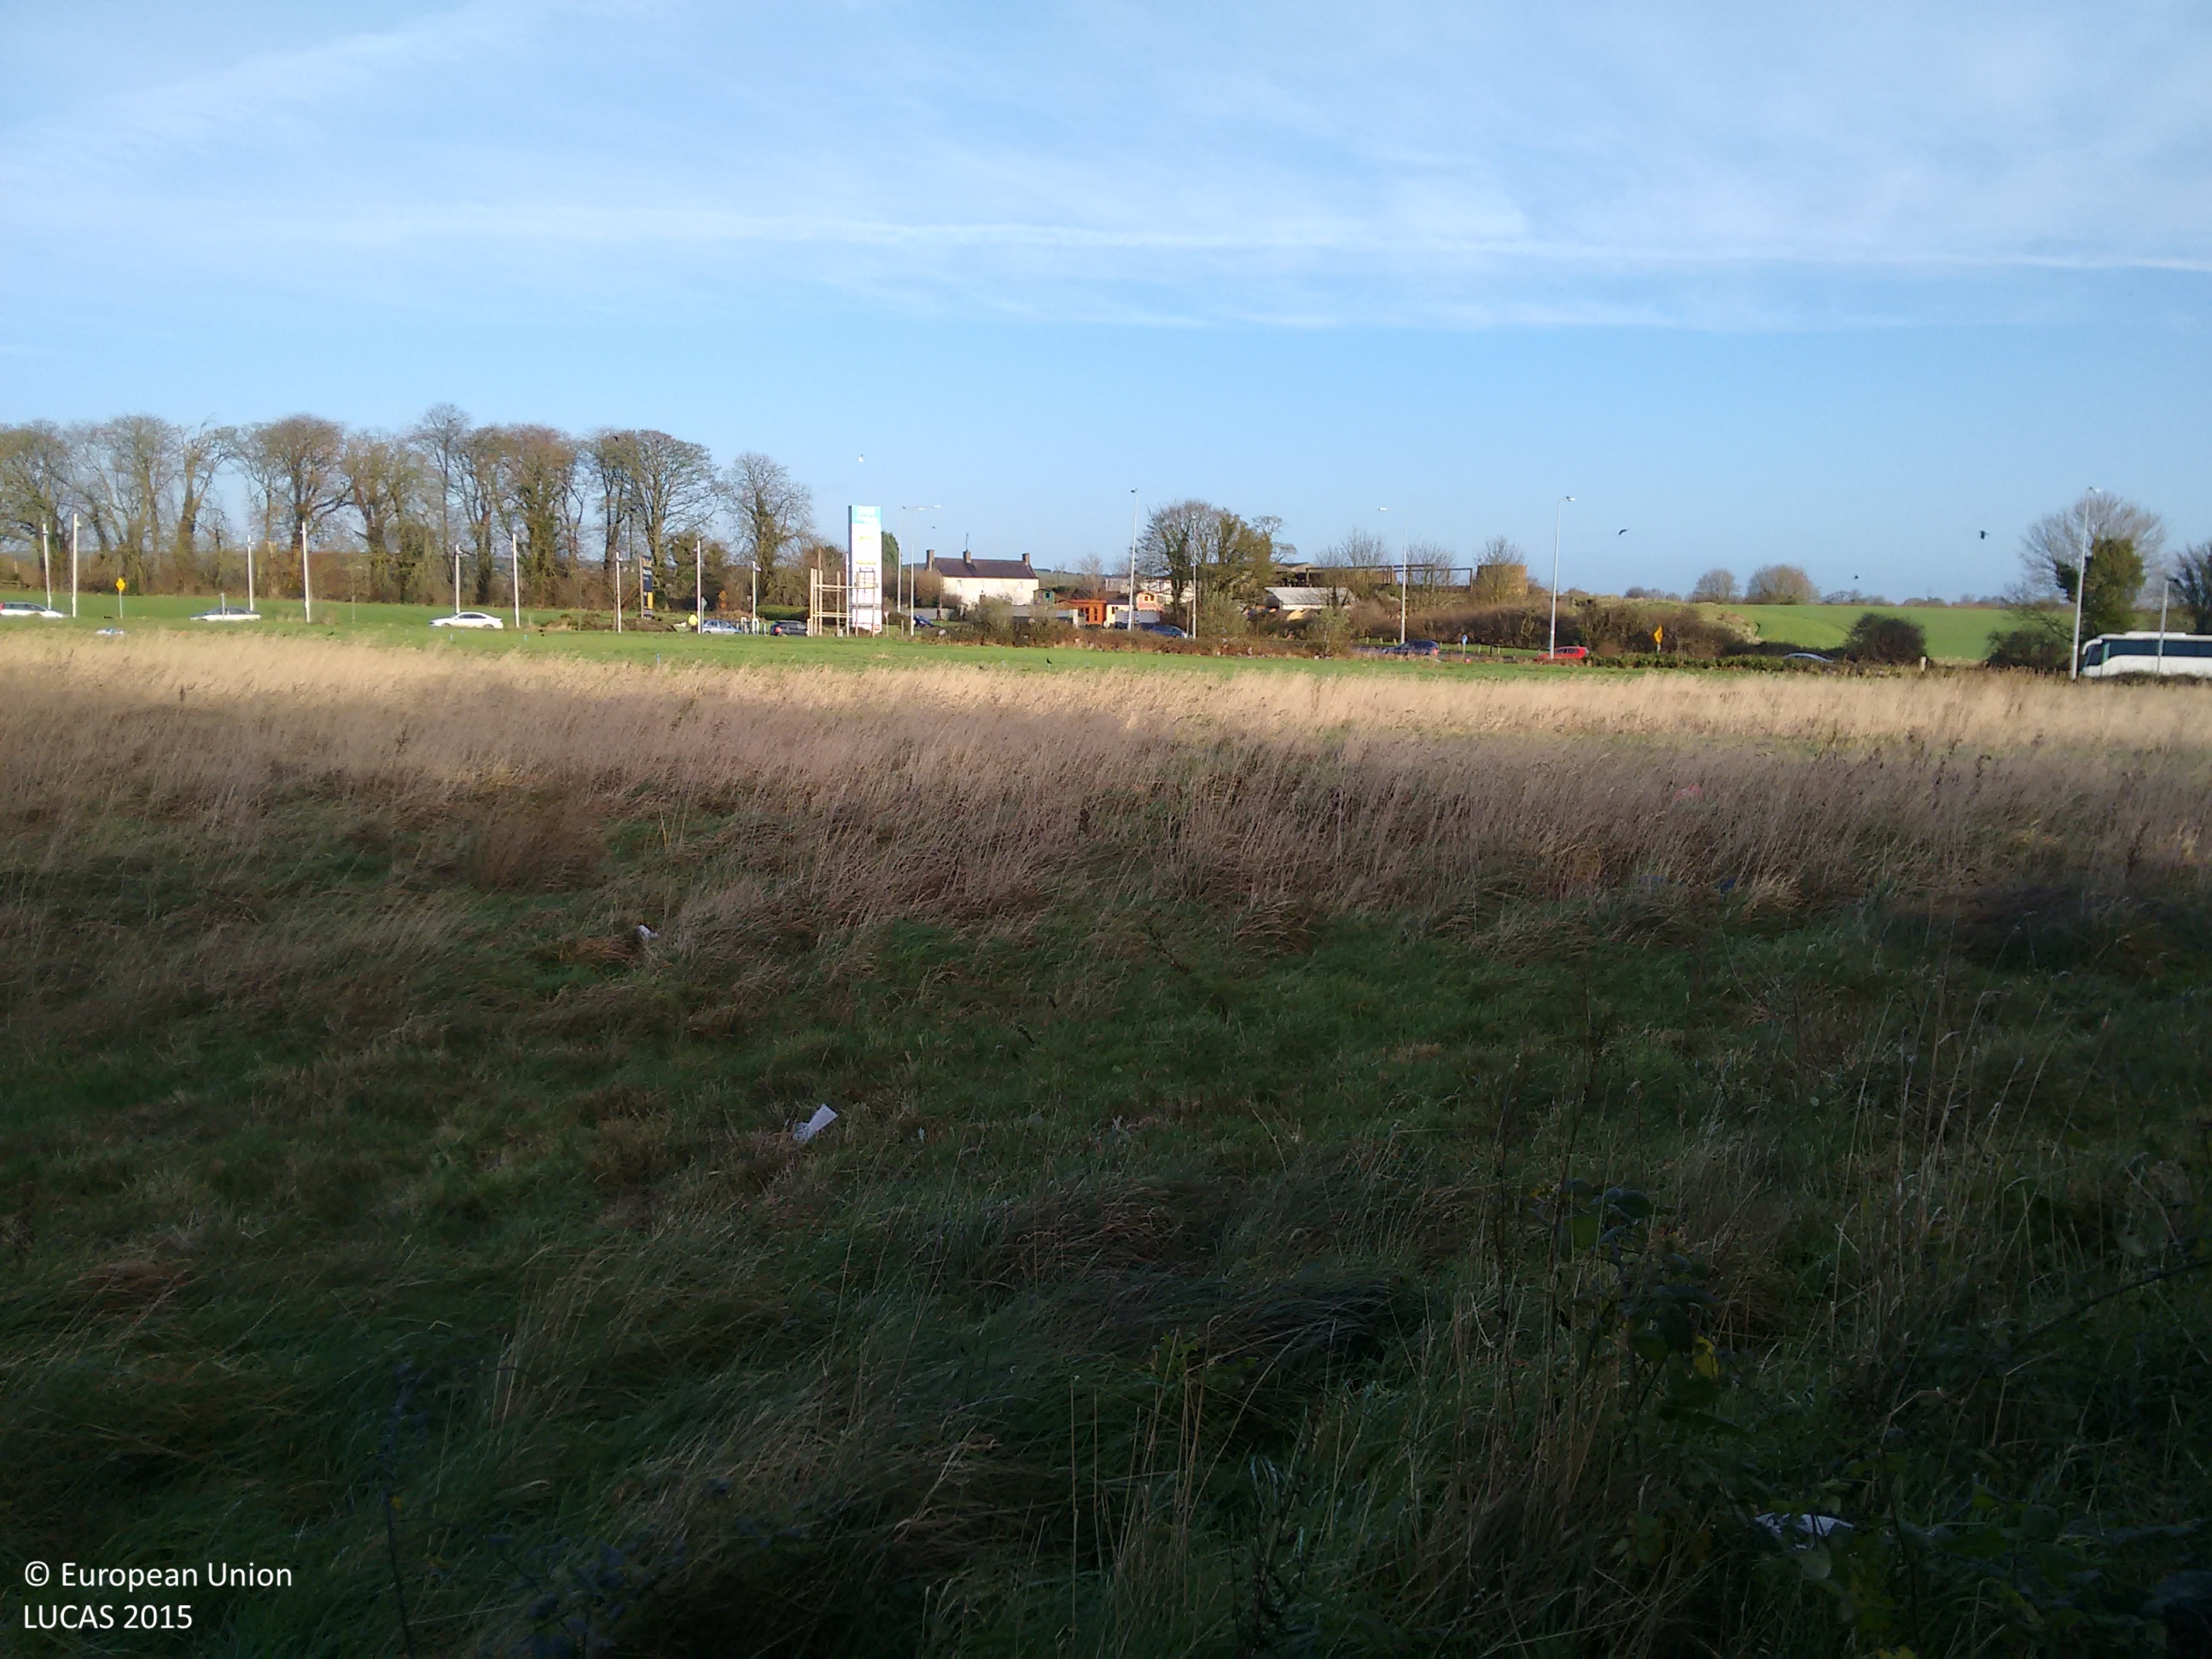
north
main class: Grassland
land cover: Spontaneously vegetated surfaces
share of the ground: > 75 %
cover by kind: herbaceous plants 95 %, shrubs 5 %
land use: Abandoned areas
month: December
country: IE
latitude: 53.7262
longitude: -6.3855
